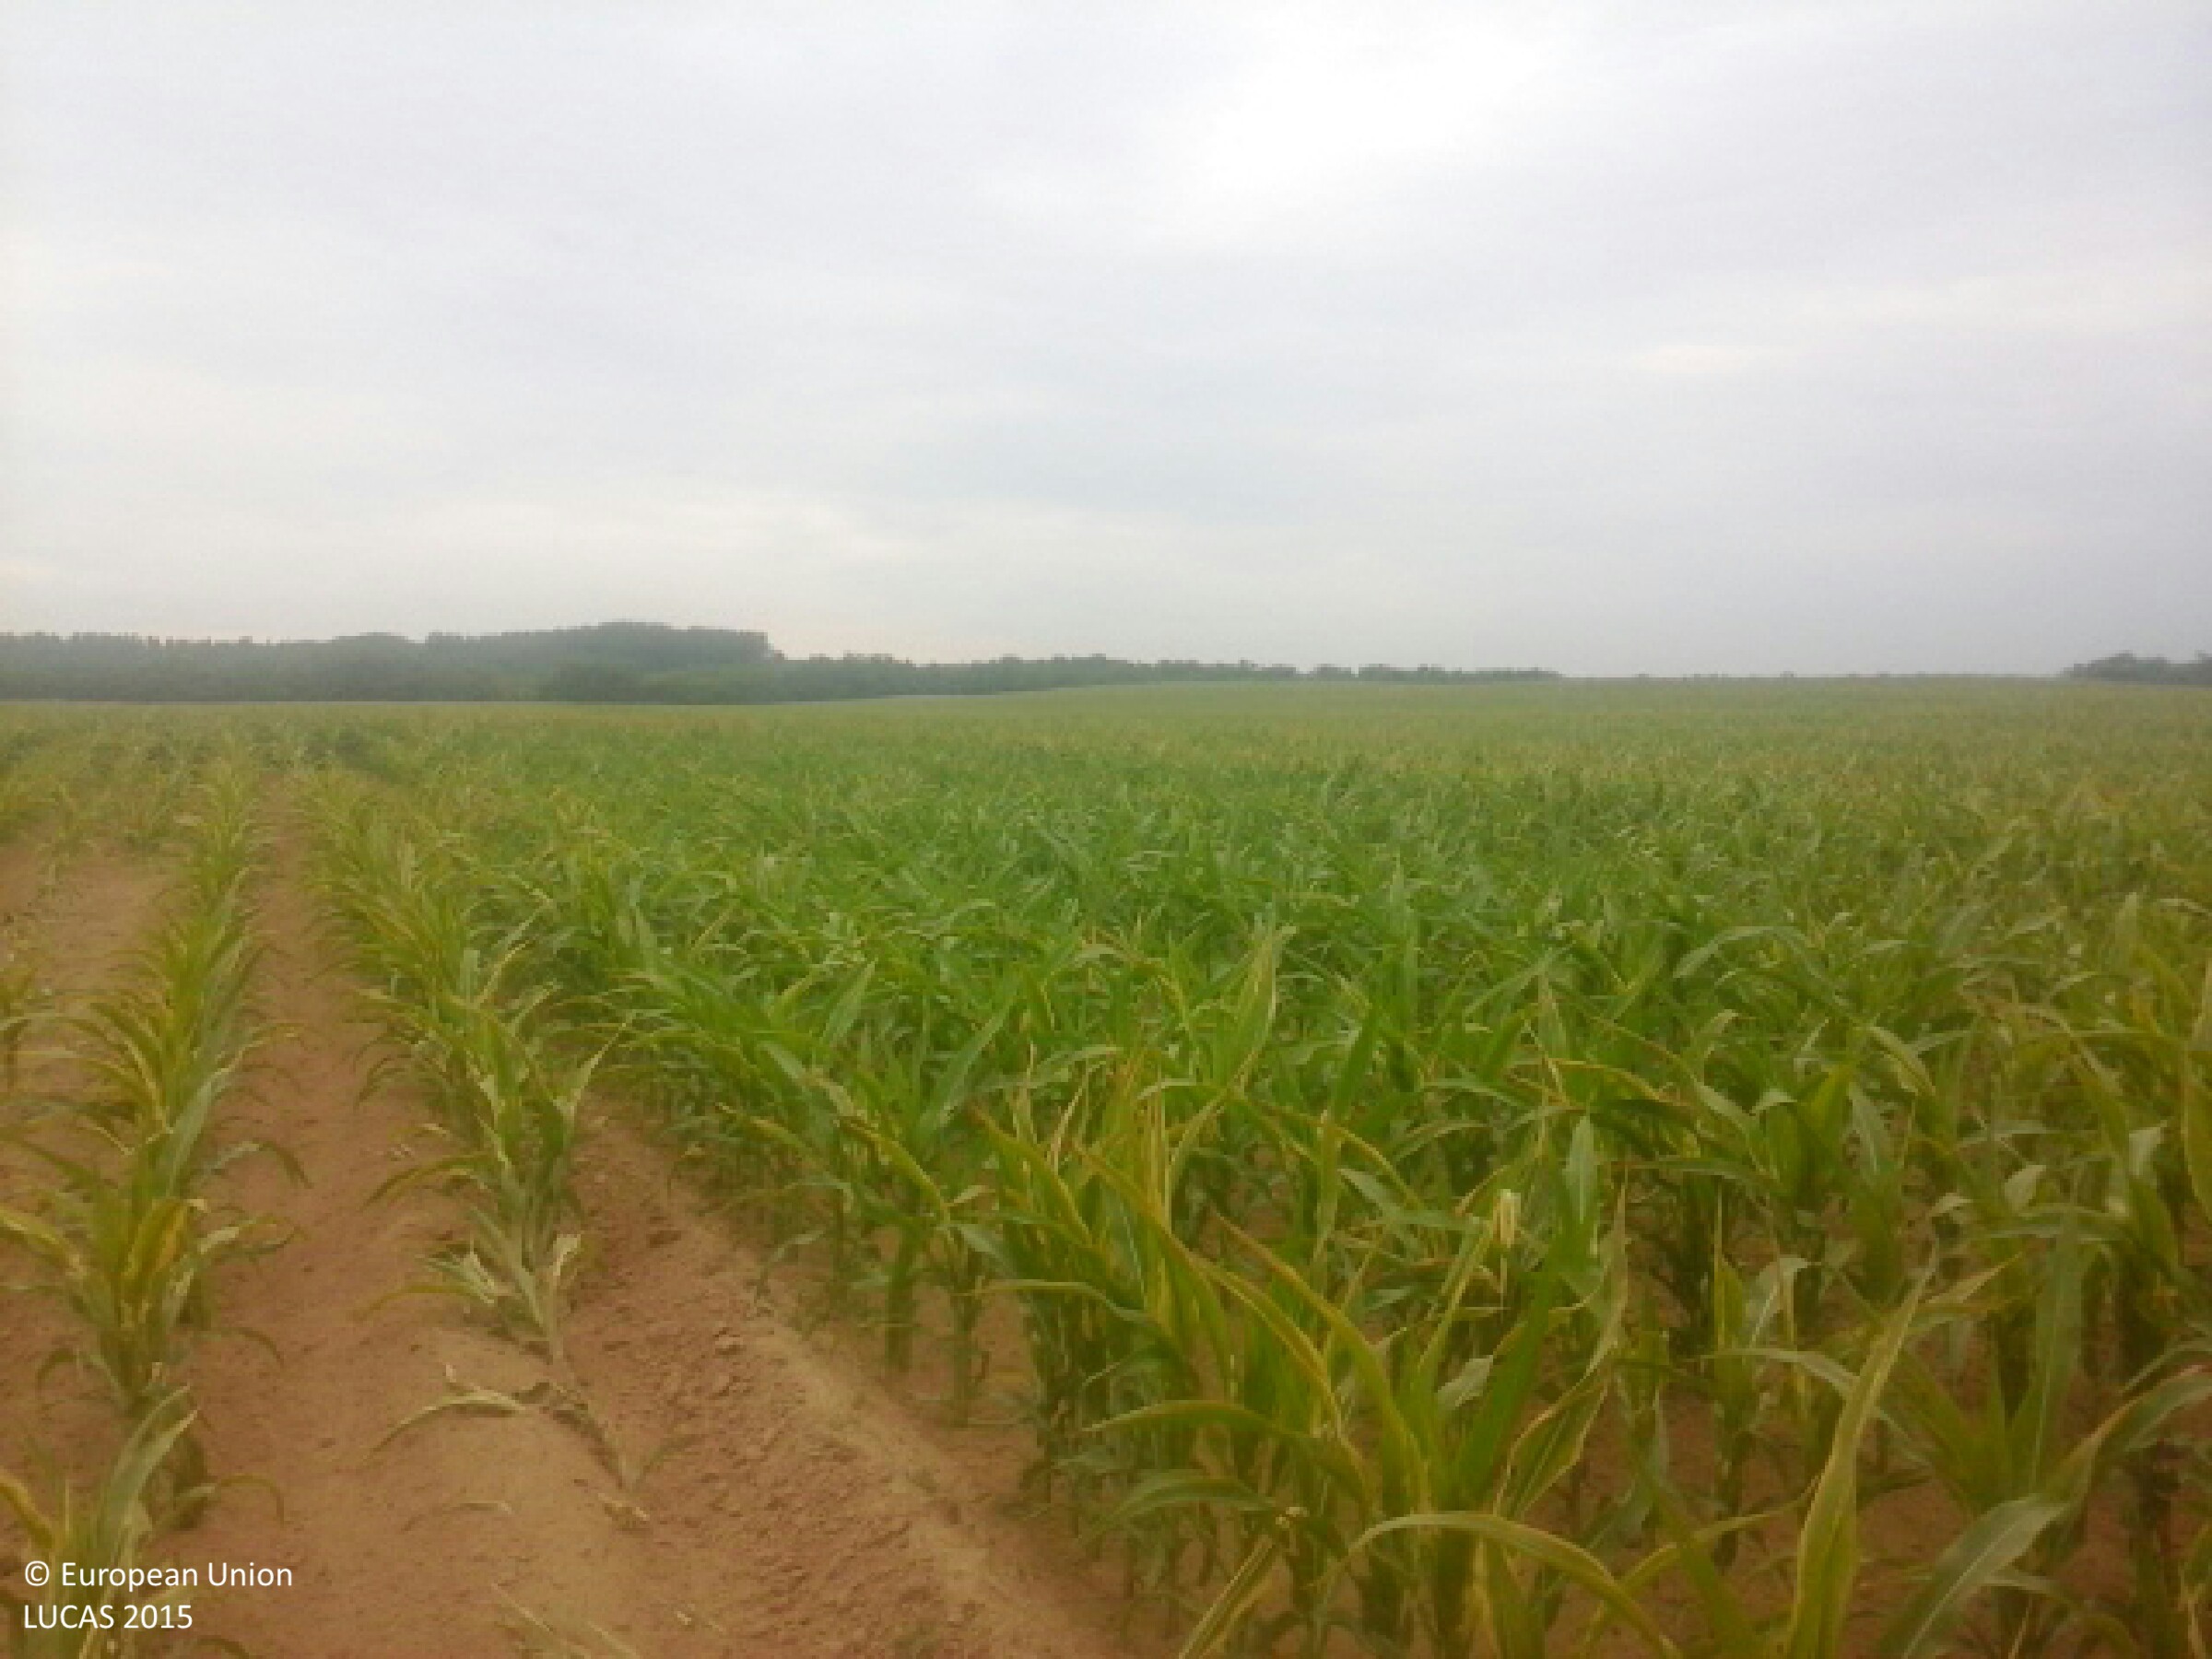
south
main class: Cropland
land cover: Maize
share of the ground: 25 - 50 %
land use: Agriculture (excluding fallow land and kitchen gardens)
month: June
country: HU
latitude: 47.9524
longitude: 22.1182
